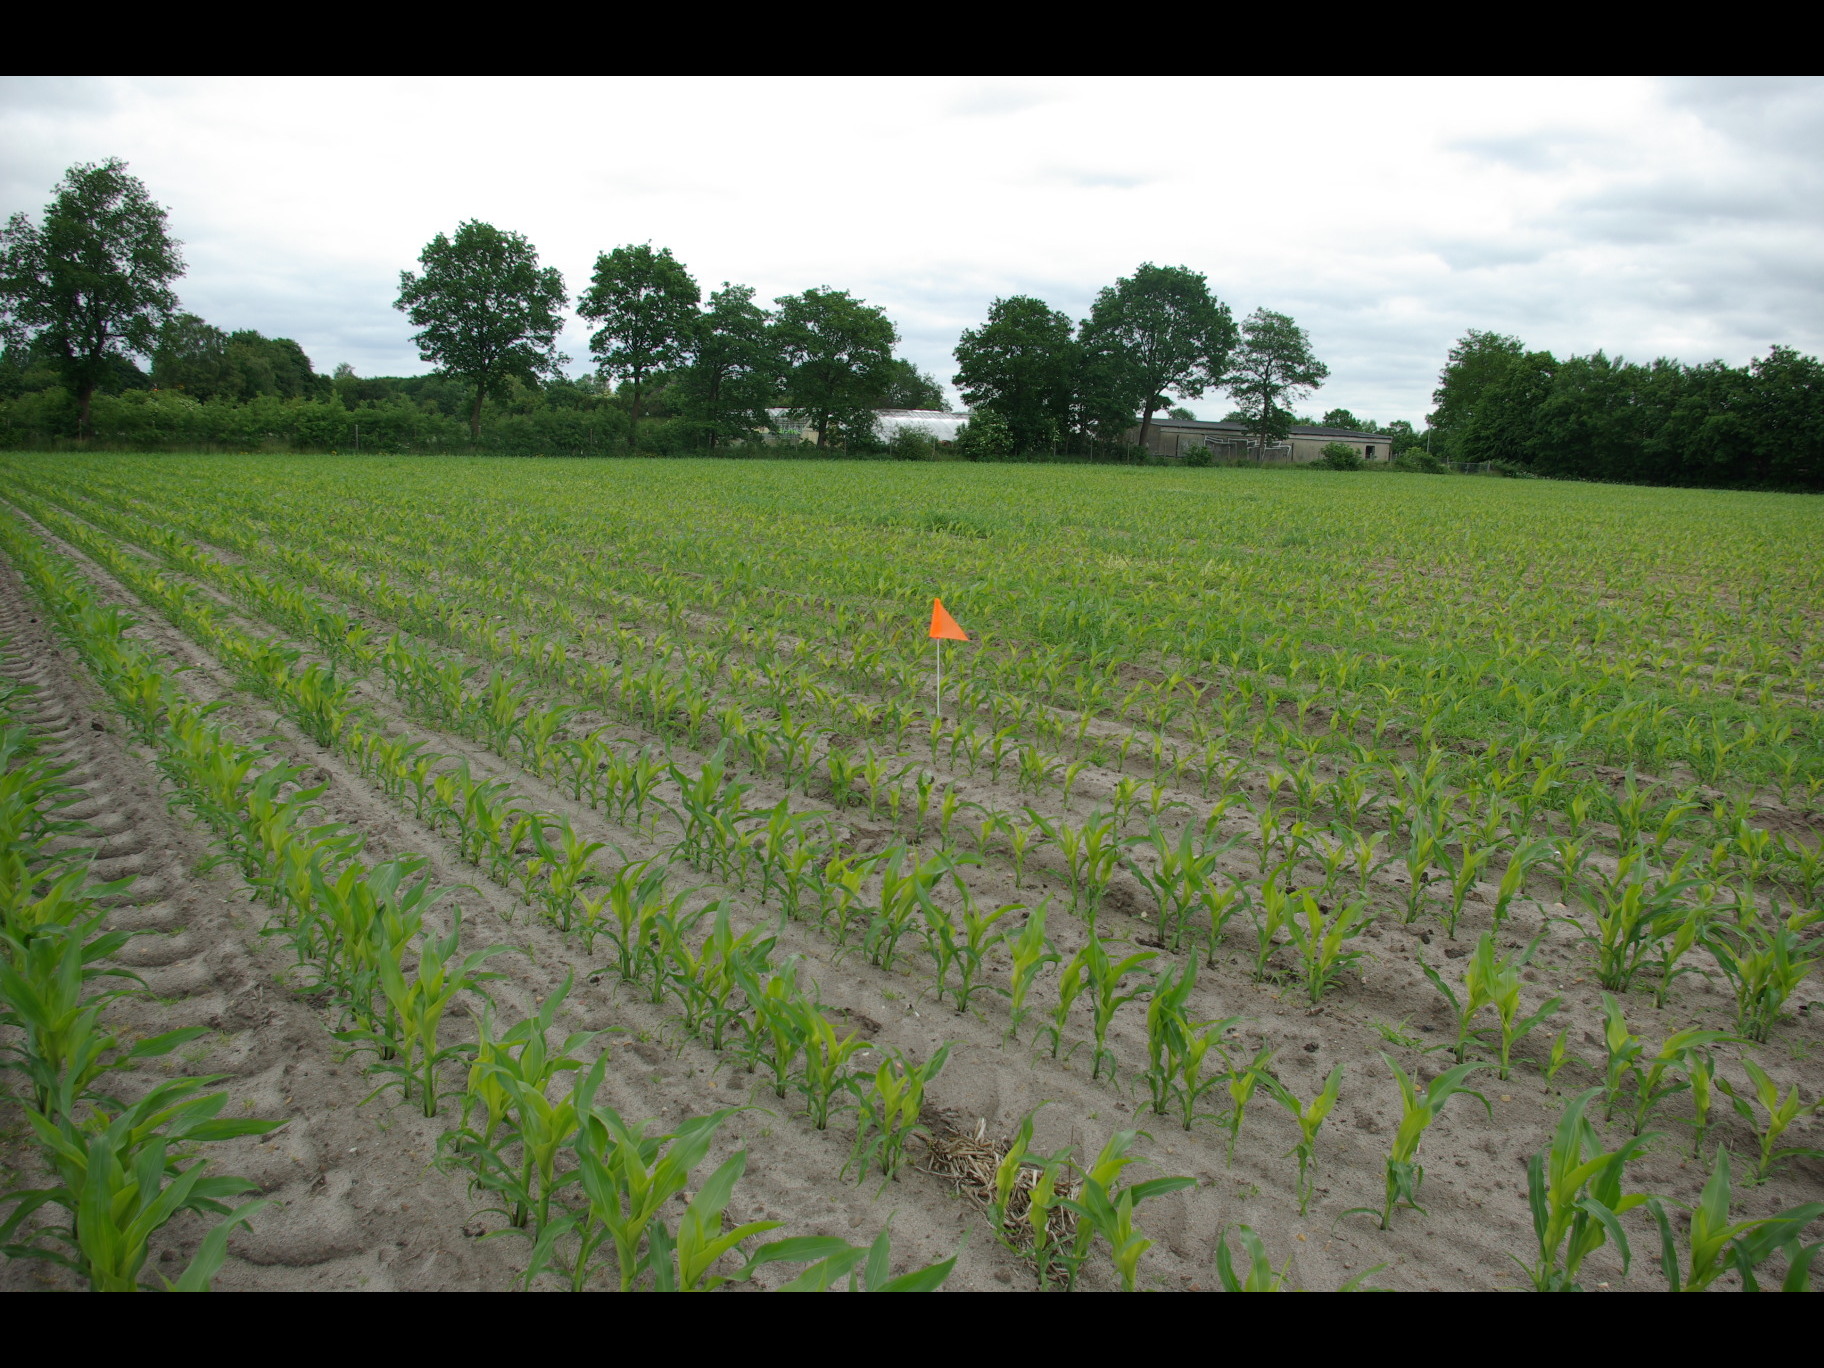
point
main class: Cropland
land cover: Maize
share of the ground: 25 - 50 %
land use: Agriculture (excluding fallow land and kitchen gardens)
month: June
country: DE
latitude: 54.0669
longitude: 9.9236
